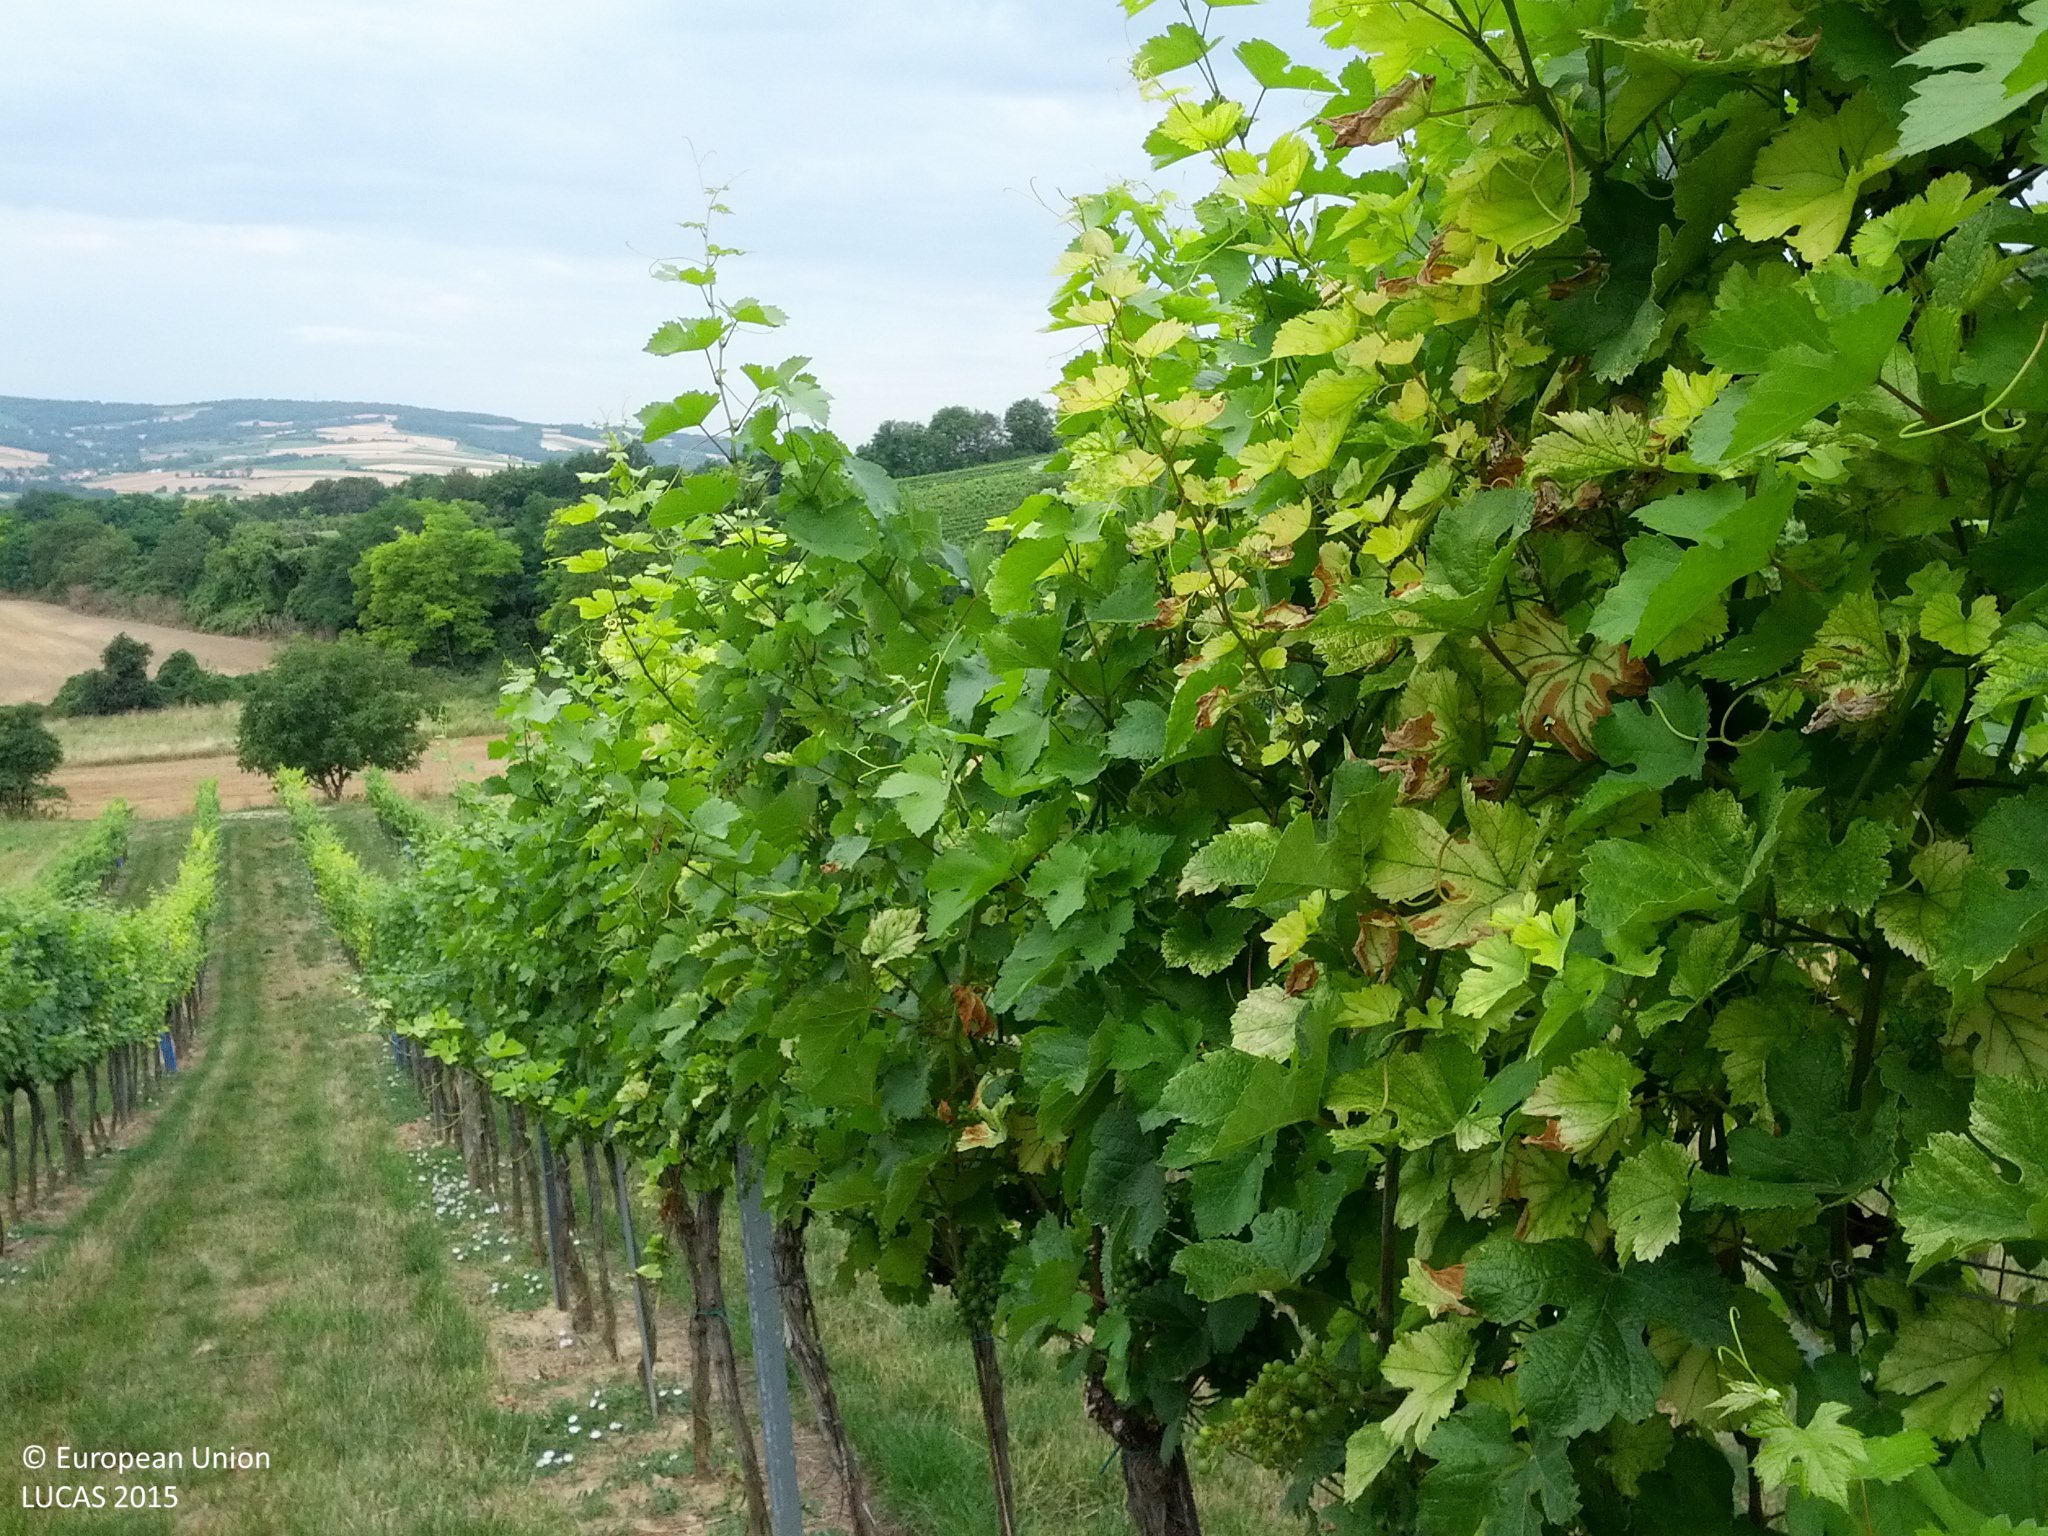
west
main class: Cropland
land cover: Vineyards
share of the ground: 50 - 75 %
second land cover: Grassland without tree/shrub cover
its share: 50 - 75 %
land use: Agriculture (excluding fallow land and kitchen gardens)
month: July
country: AT
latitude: 48.5037
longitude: 16.1359
